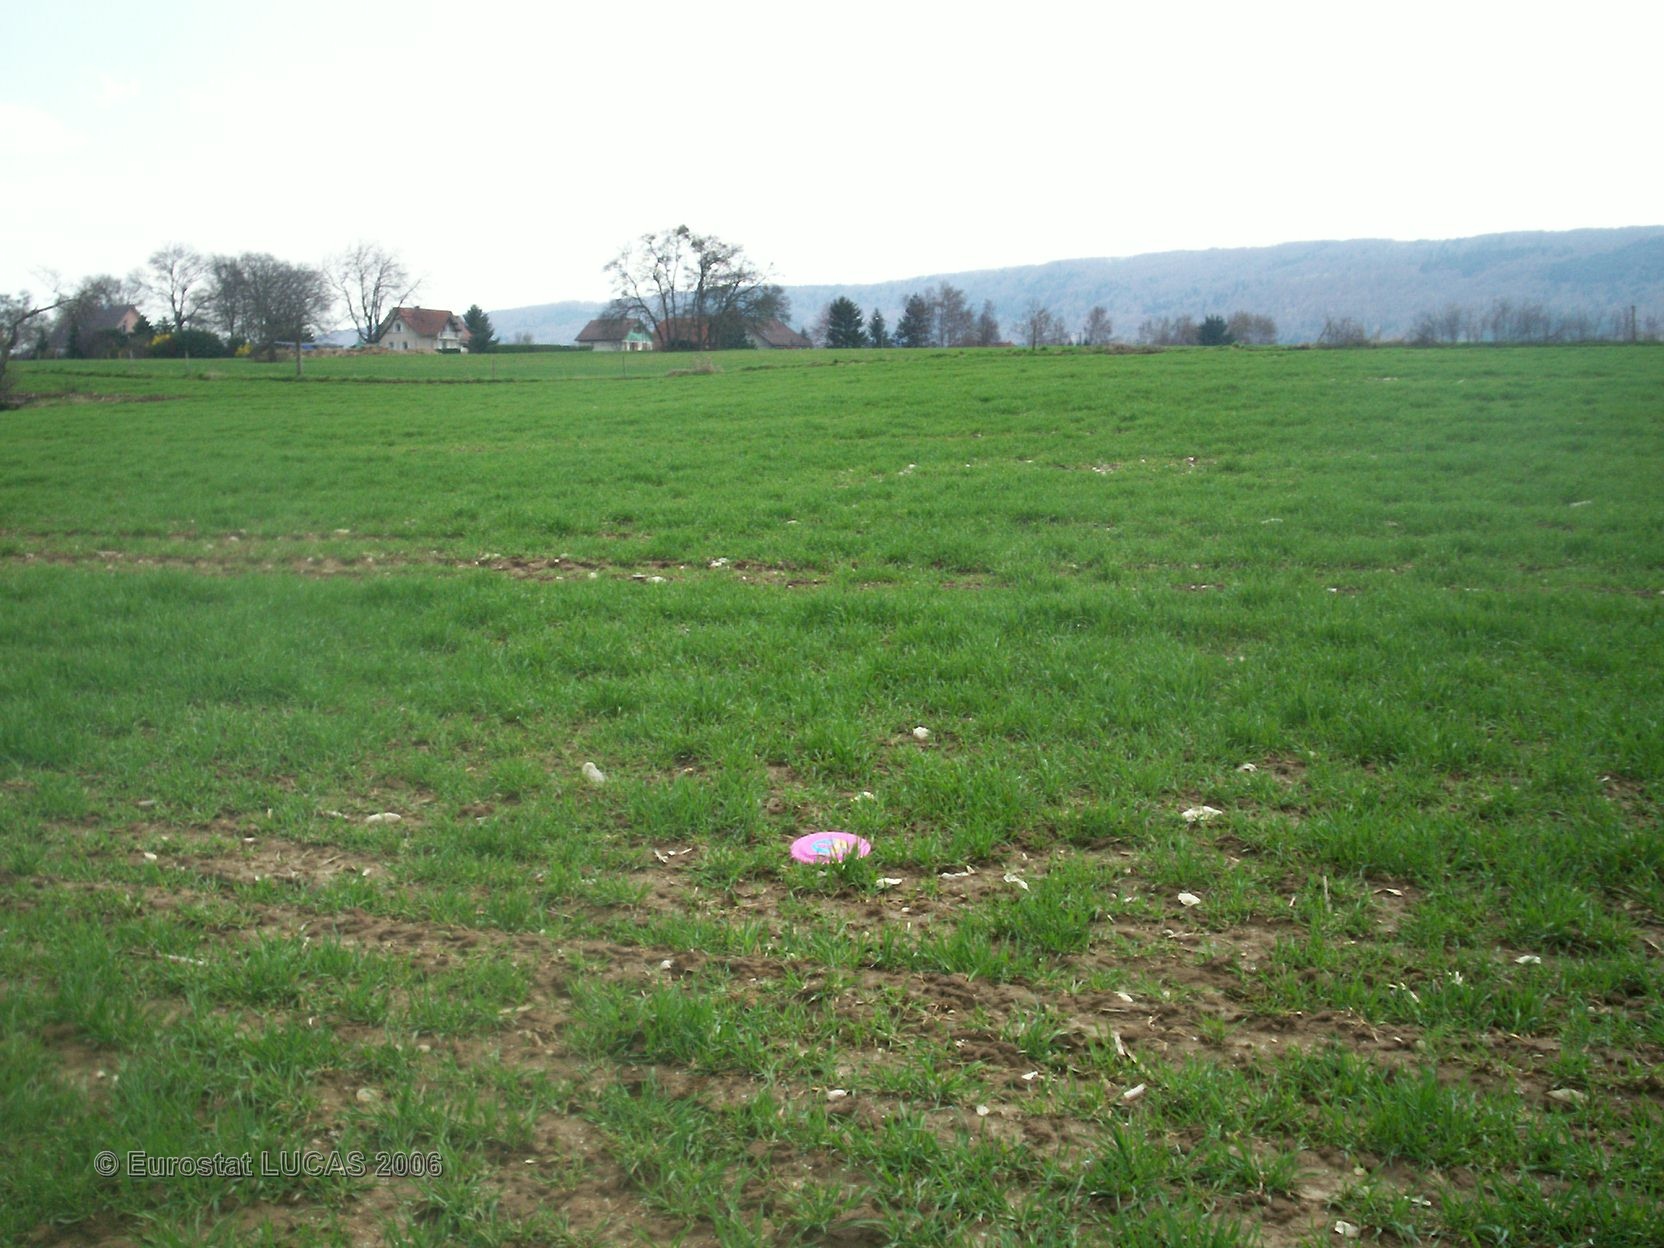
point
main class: Cropland
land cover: Barley
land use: Agriculture (excluding fallow land and kitchen gardens)
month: April
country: FR
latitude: 47.3856
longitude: 6.8359
